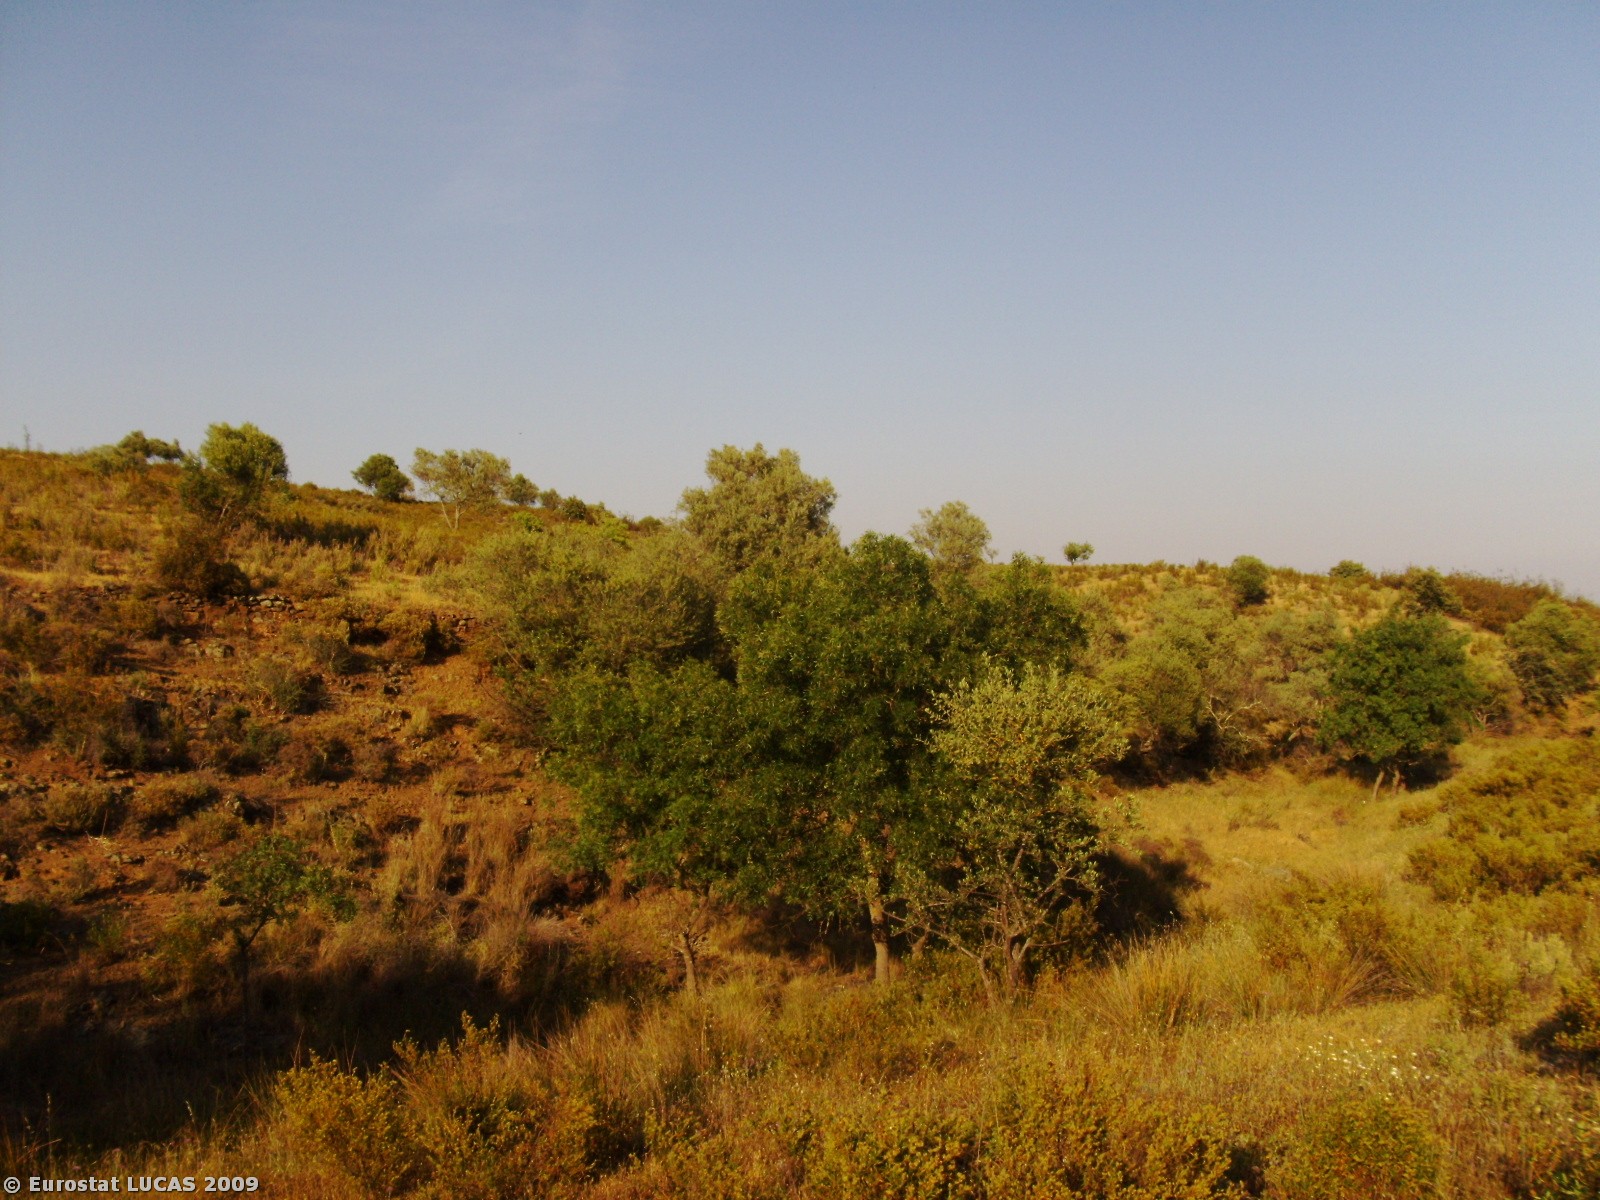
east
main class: Cropland
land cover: Olive groves
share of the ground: < 10 %
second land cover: Spontaneously vegetated surfaces
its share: > 75 %
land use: Agriculture (excluding fallow land and kitchen gardens)
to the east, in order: Olive groves; Spontaneously vegetated surfaces; Rivers and streams; Shrubland with sparse tree cover; Dry stone walls; Shrubland with sparse tree cover; Lines of trees; Dry stone walls; Shrubland with sparse tree cover
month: May
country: PT
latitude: 37.2852
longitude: -7.4529
